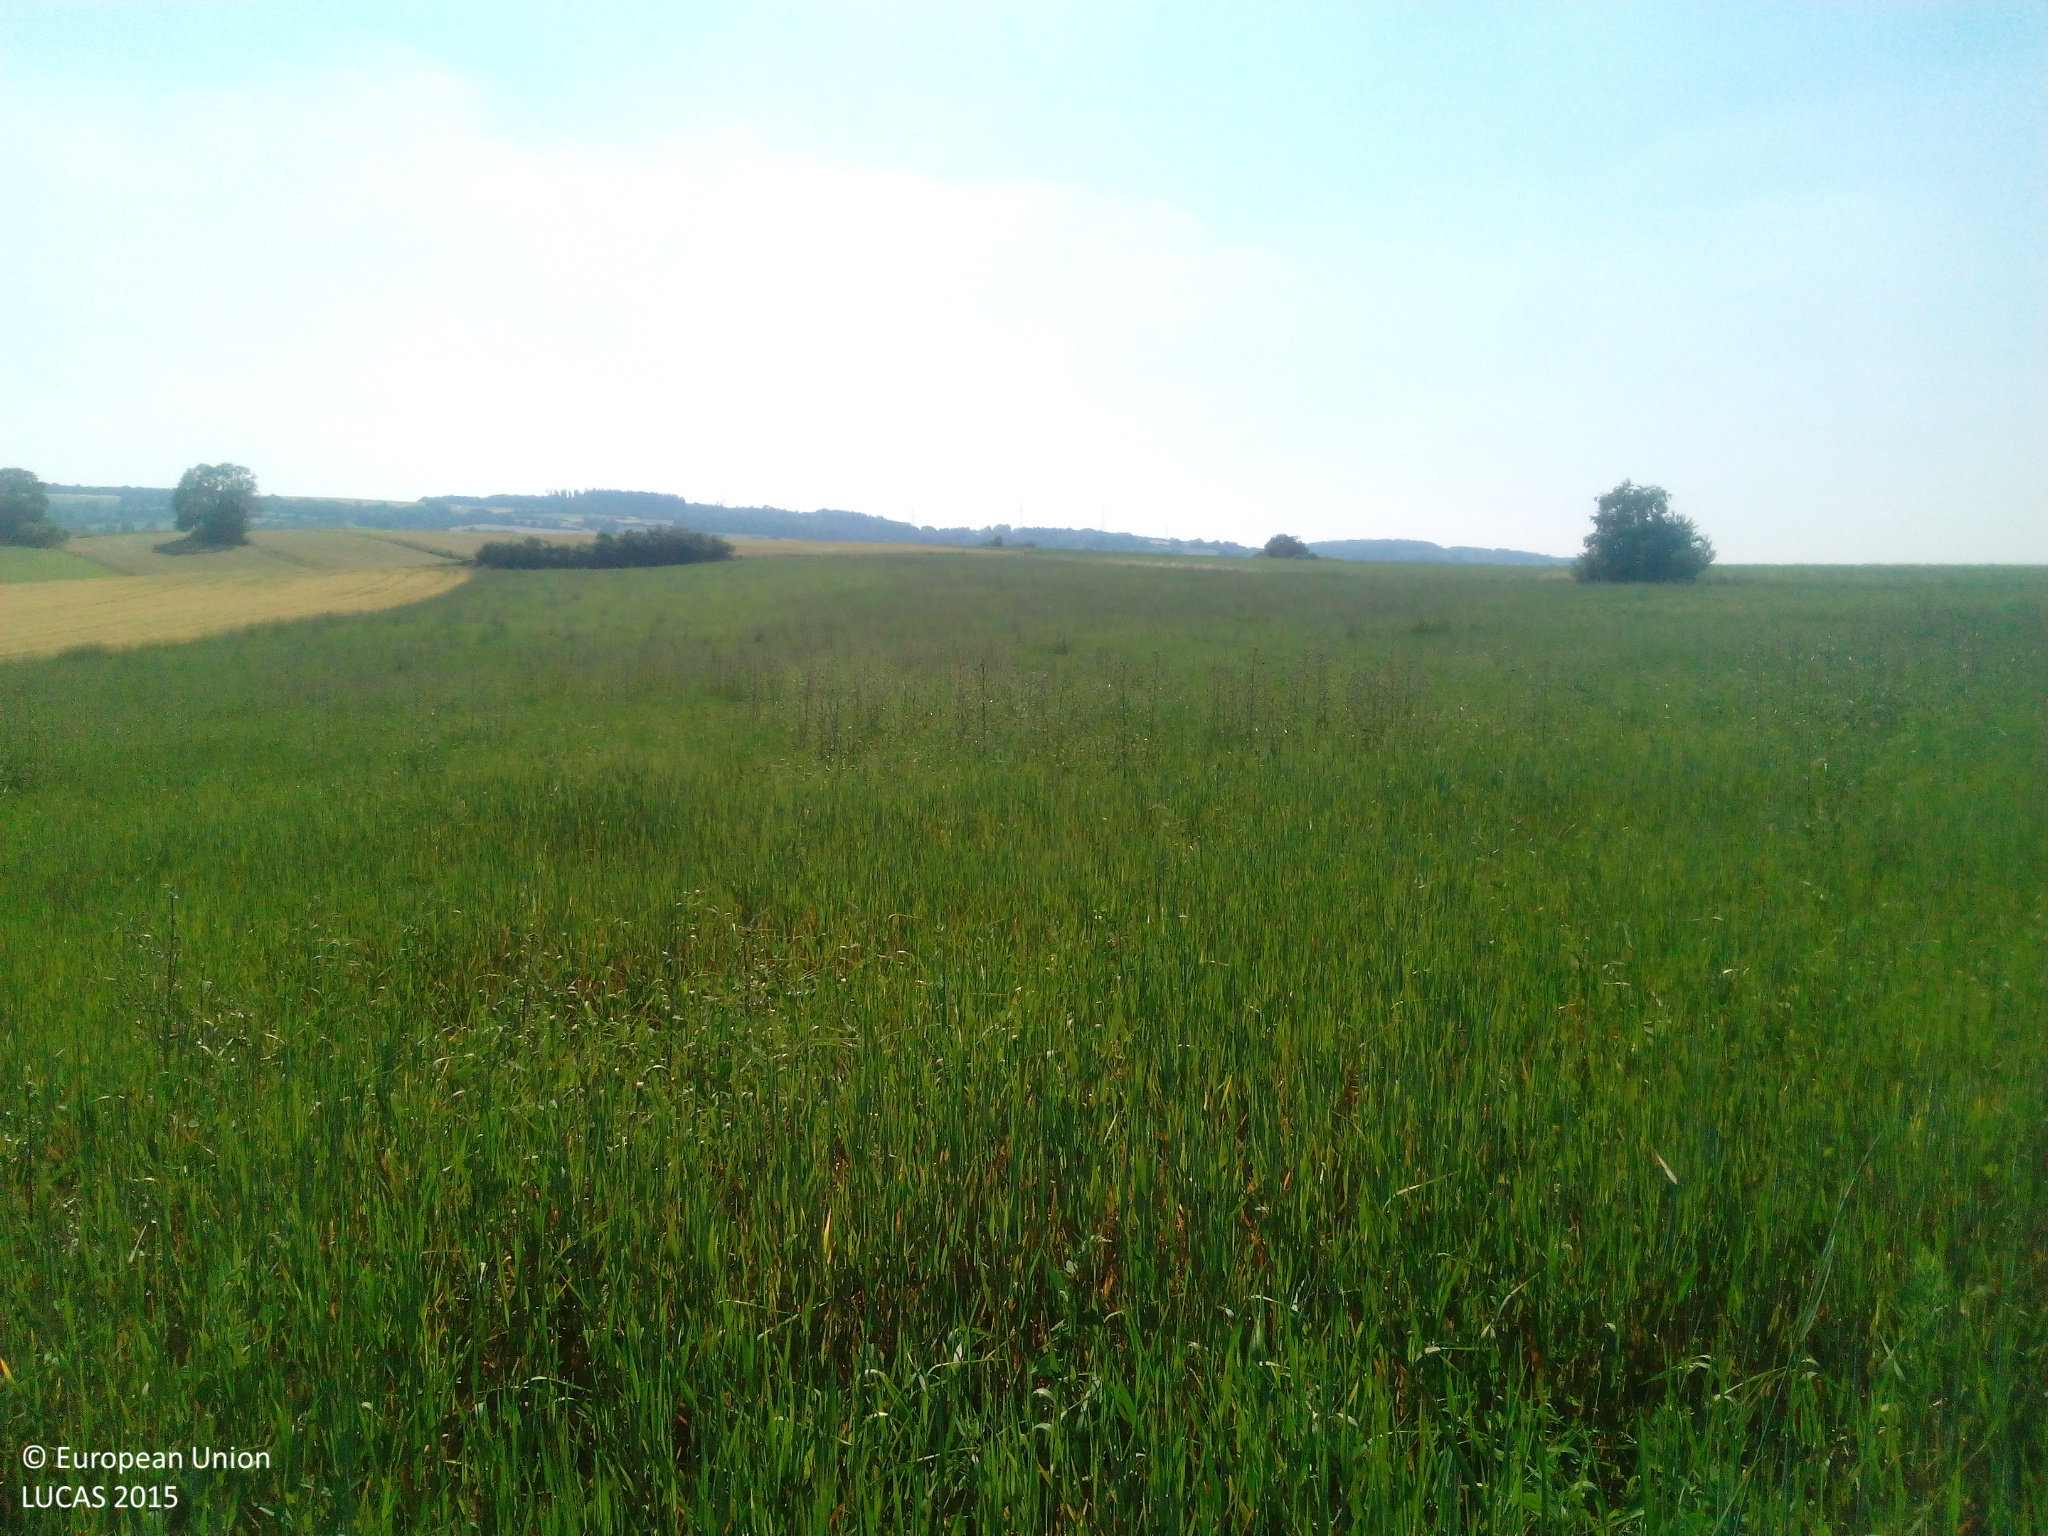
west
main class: Cropland
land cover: Common wheat
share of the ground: > 75 %
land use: Agriculture (excluding fallow land and kitchen gardens)
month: July
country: DE
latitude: 50.1561
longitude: 11.5252
